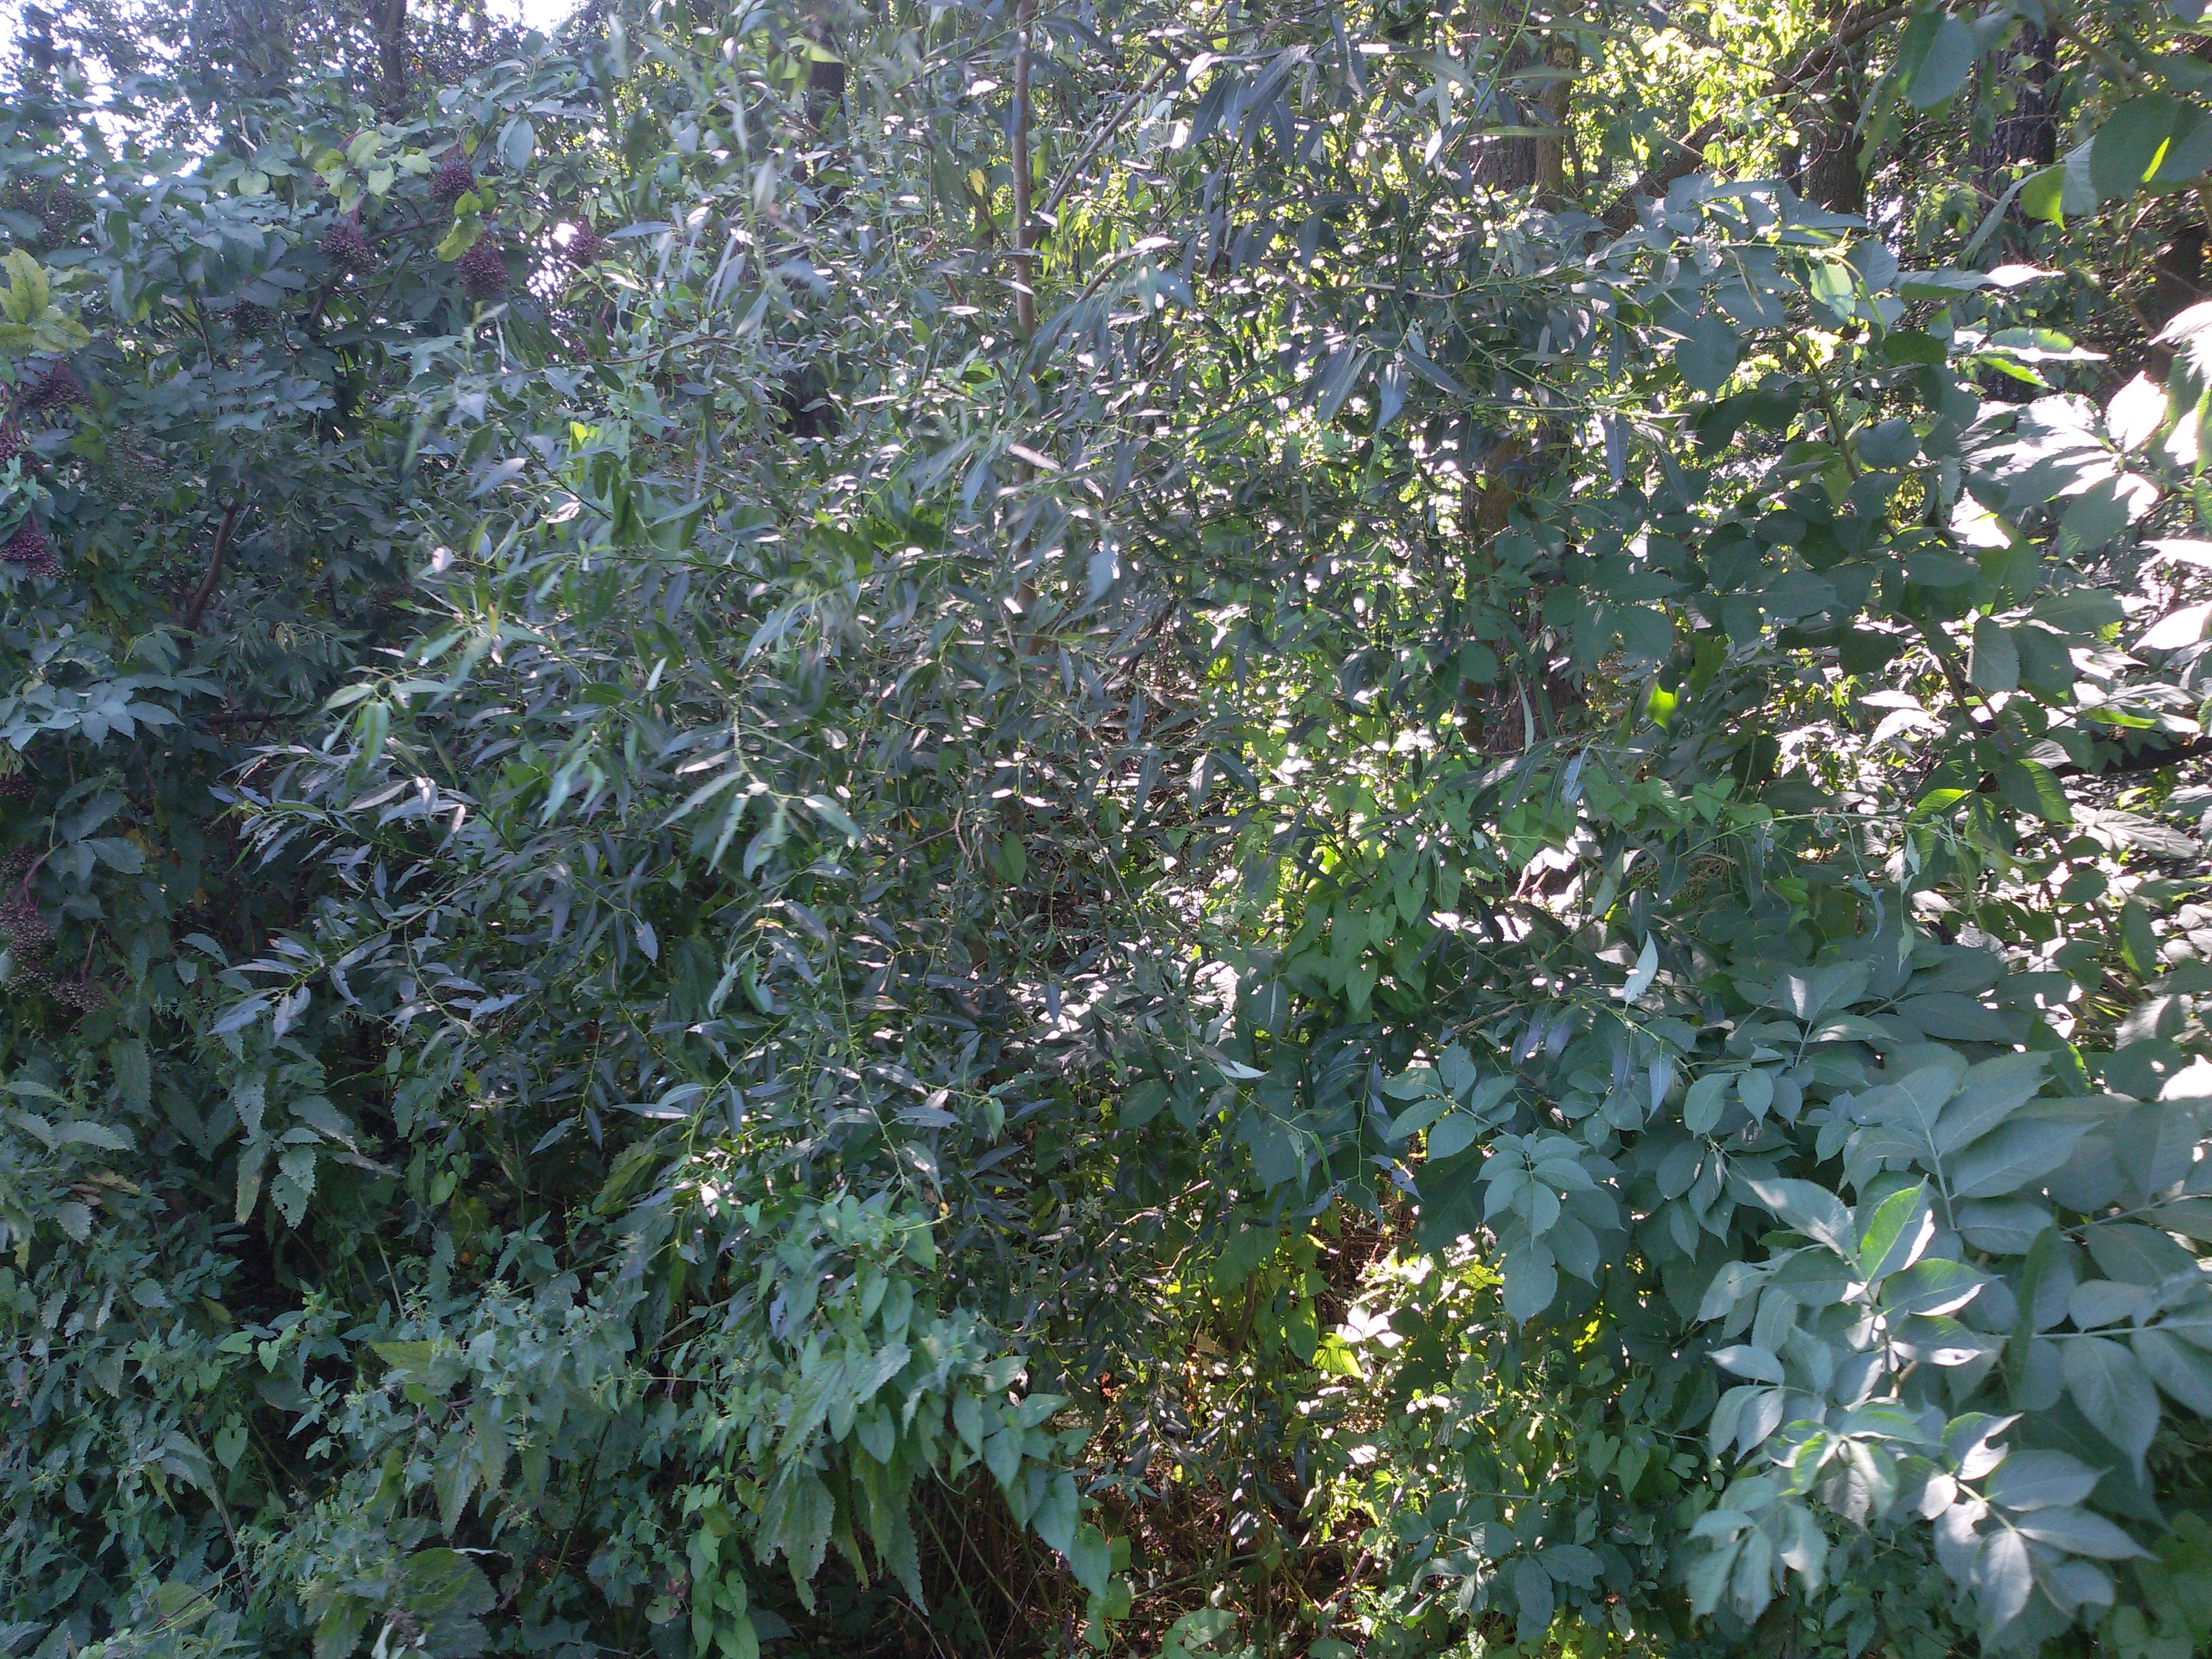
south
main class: Woodland
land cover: Broadleaved woodland
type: mesophytic deciduous forest
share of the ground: > 75 %
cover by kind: broadleaved forest trees 95 %, shrubs 5 %
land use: Forestry
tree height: > 5 m
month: August
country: PL
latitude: 52.2217
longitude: 22.1669
